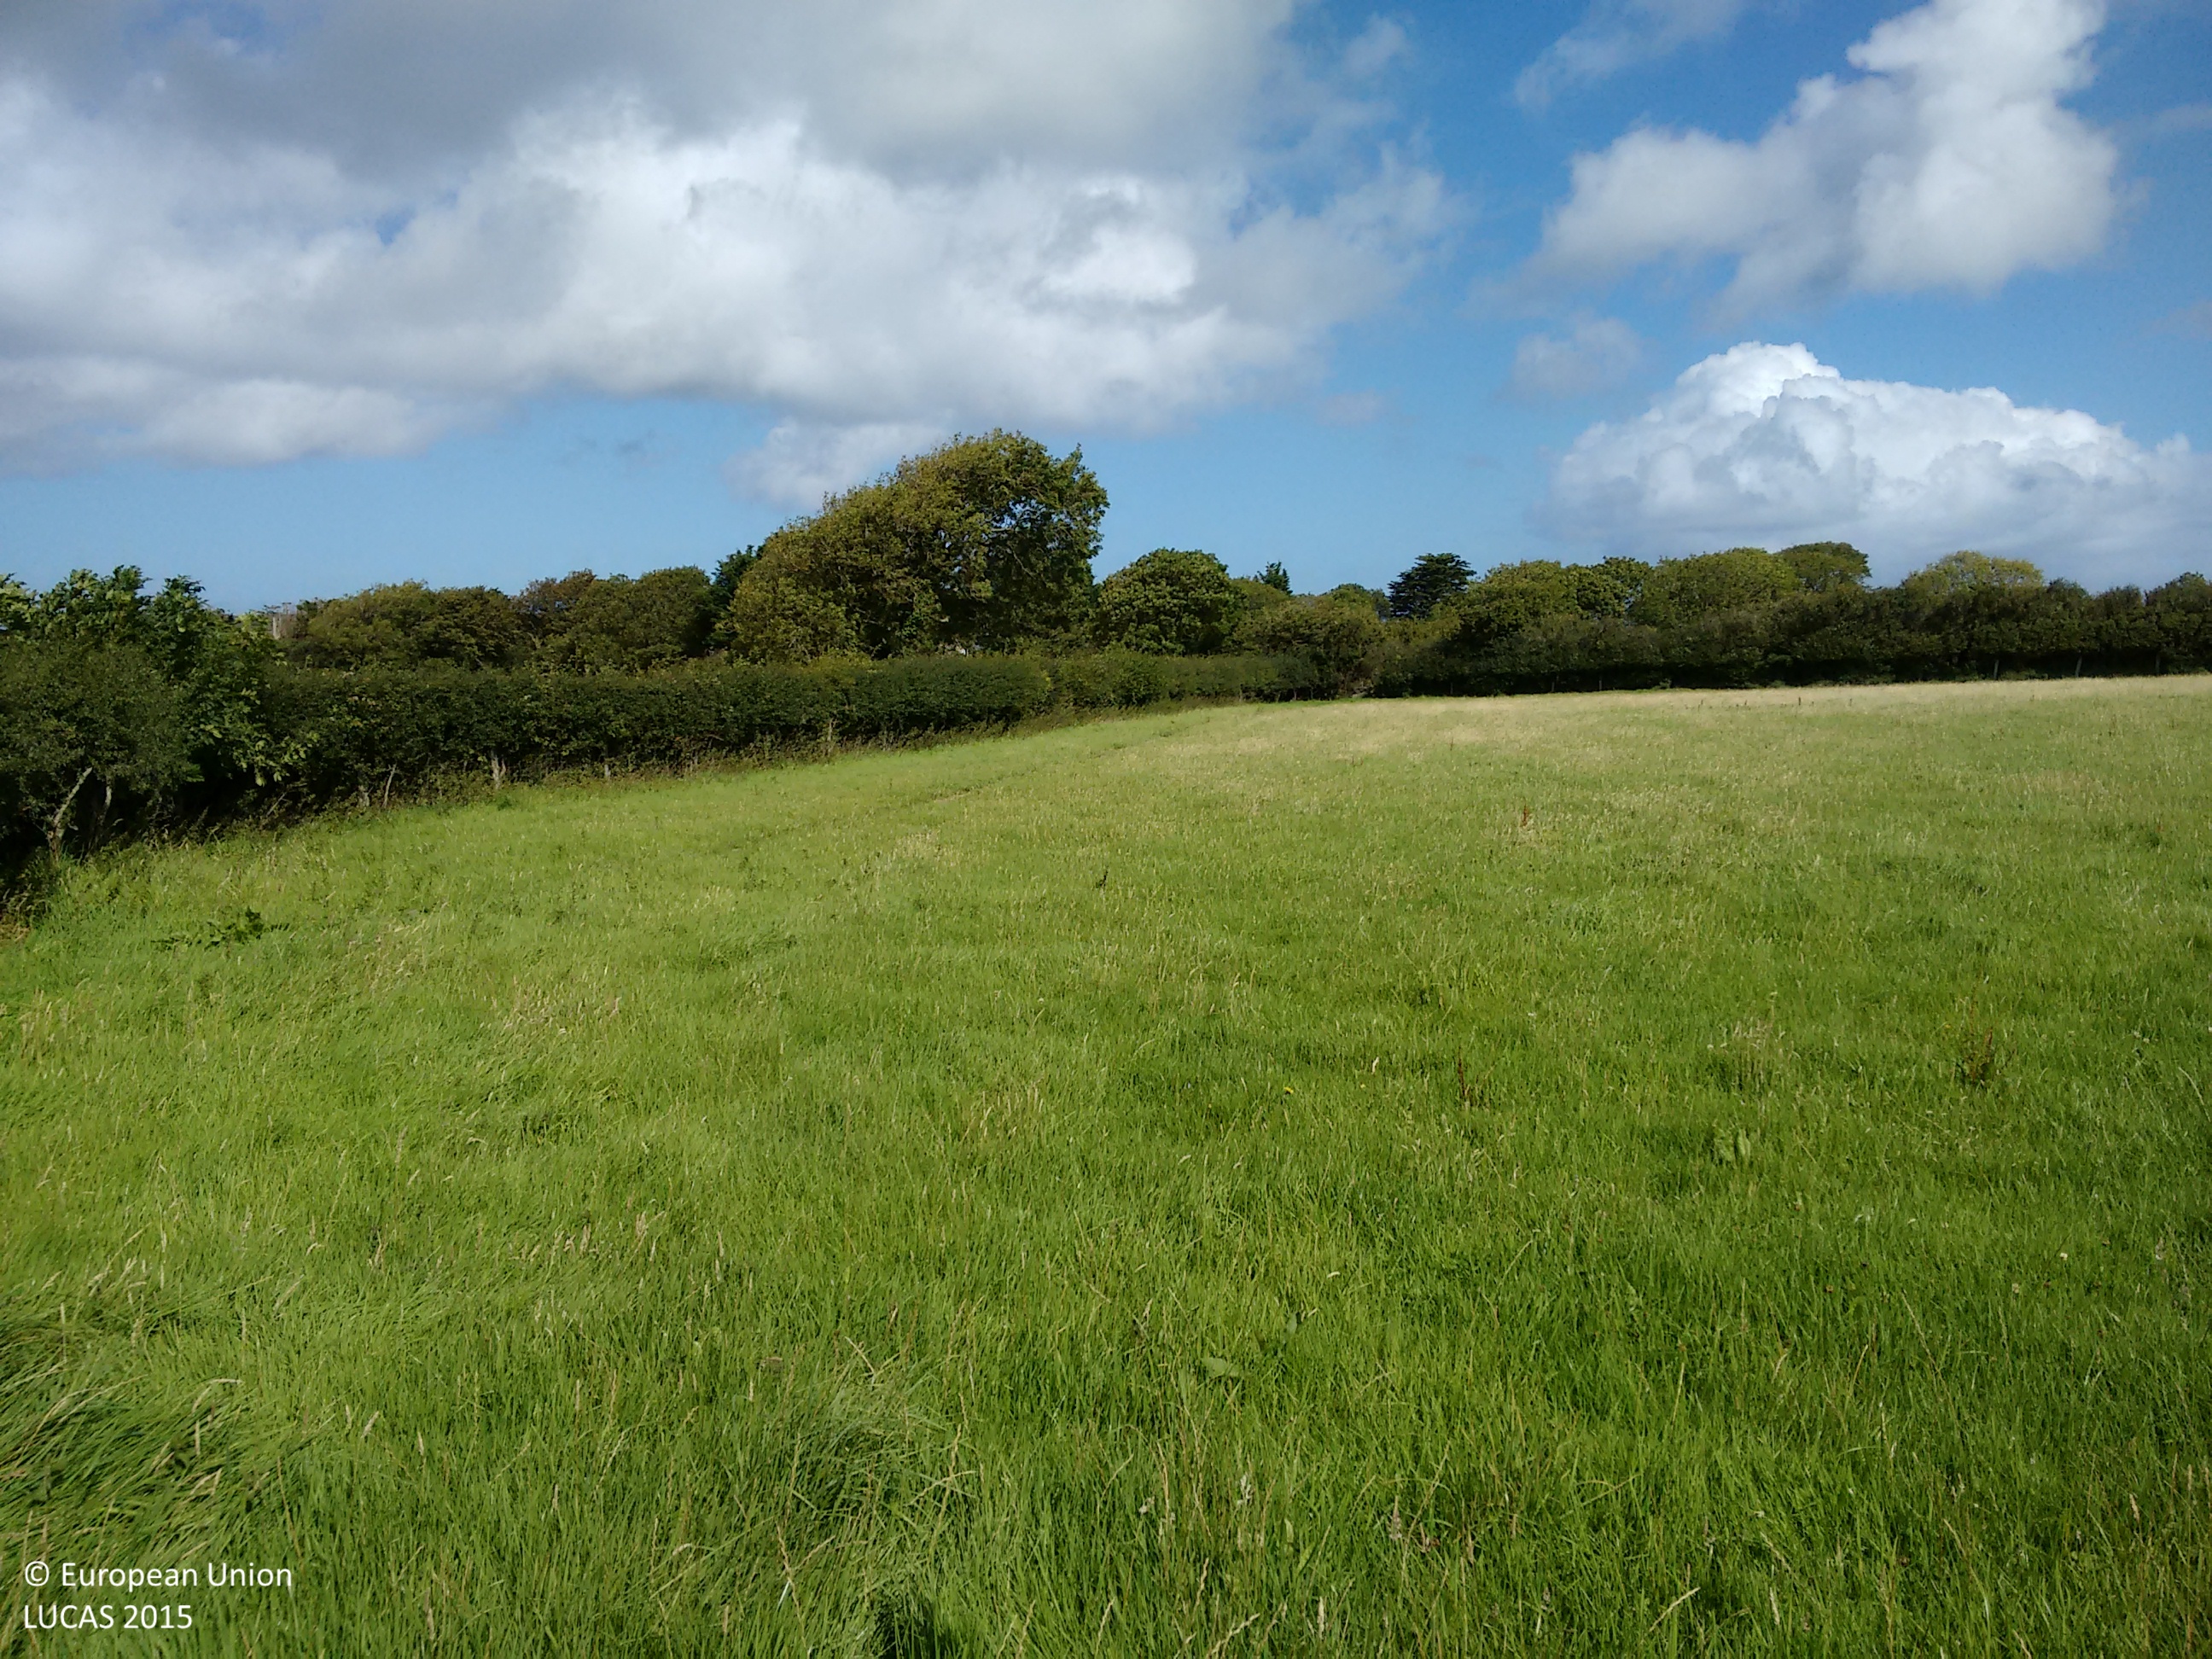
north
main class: Grassland
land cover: Grassland without tree/shrub cover
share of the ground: > 75 %
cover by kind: herbaceous plants 100 %
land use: Agriculture (excluding fallow land and kitchen gardens)
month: August
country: GB
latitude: 52.0148
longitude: -4.9040
